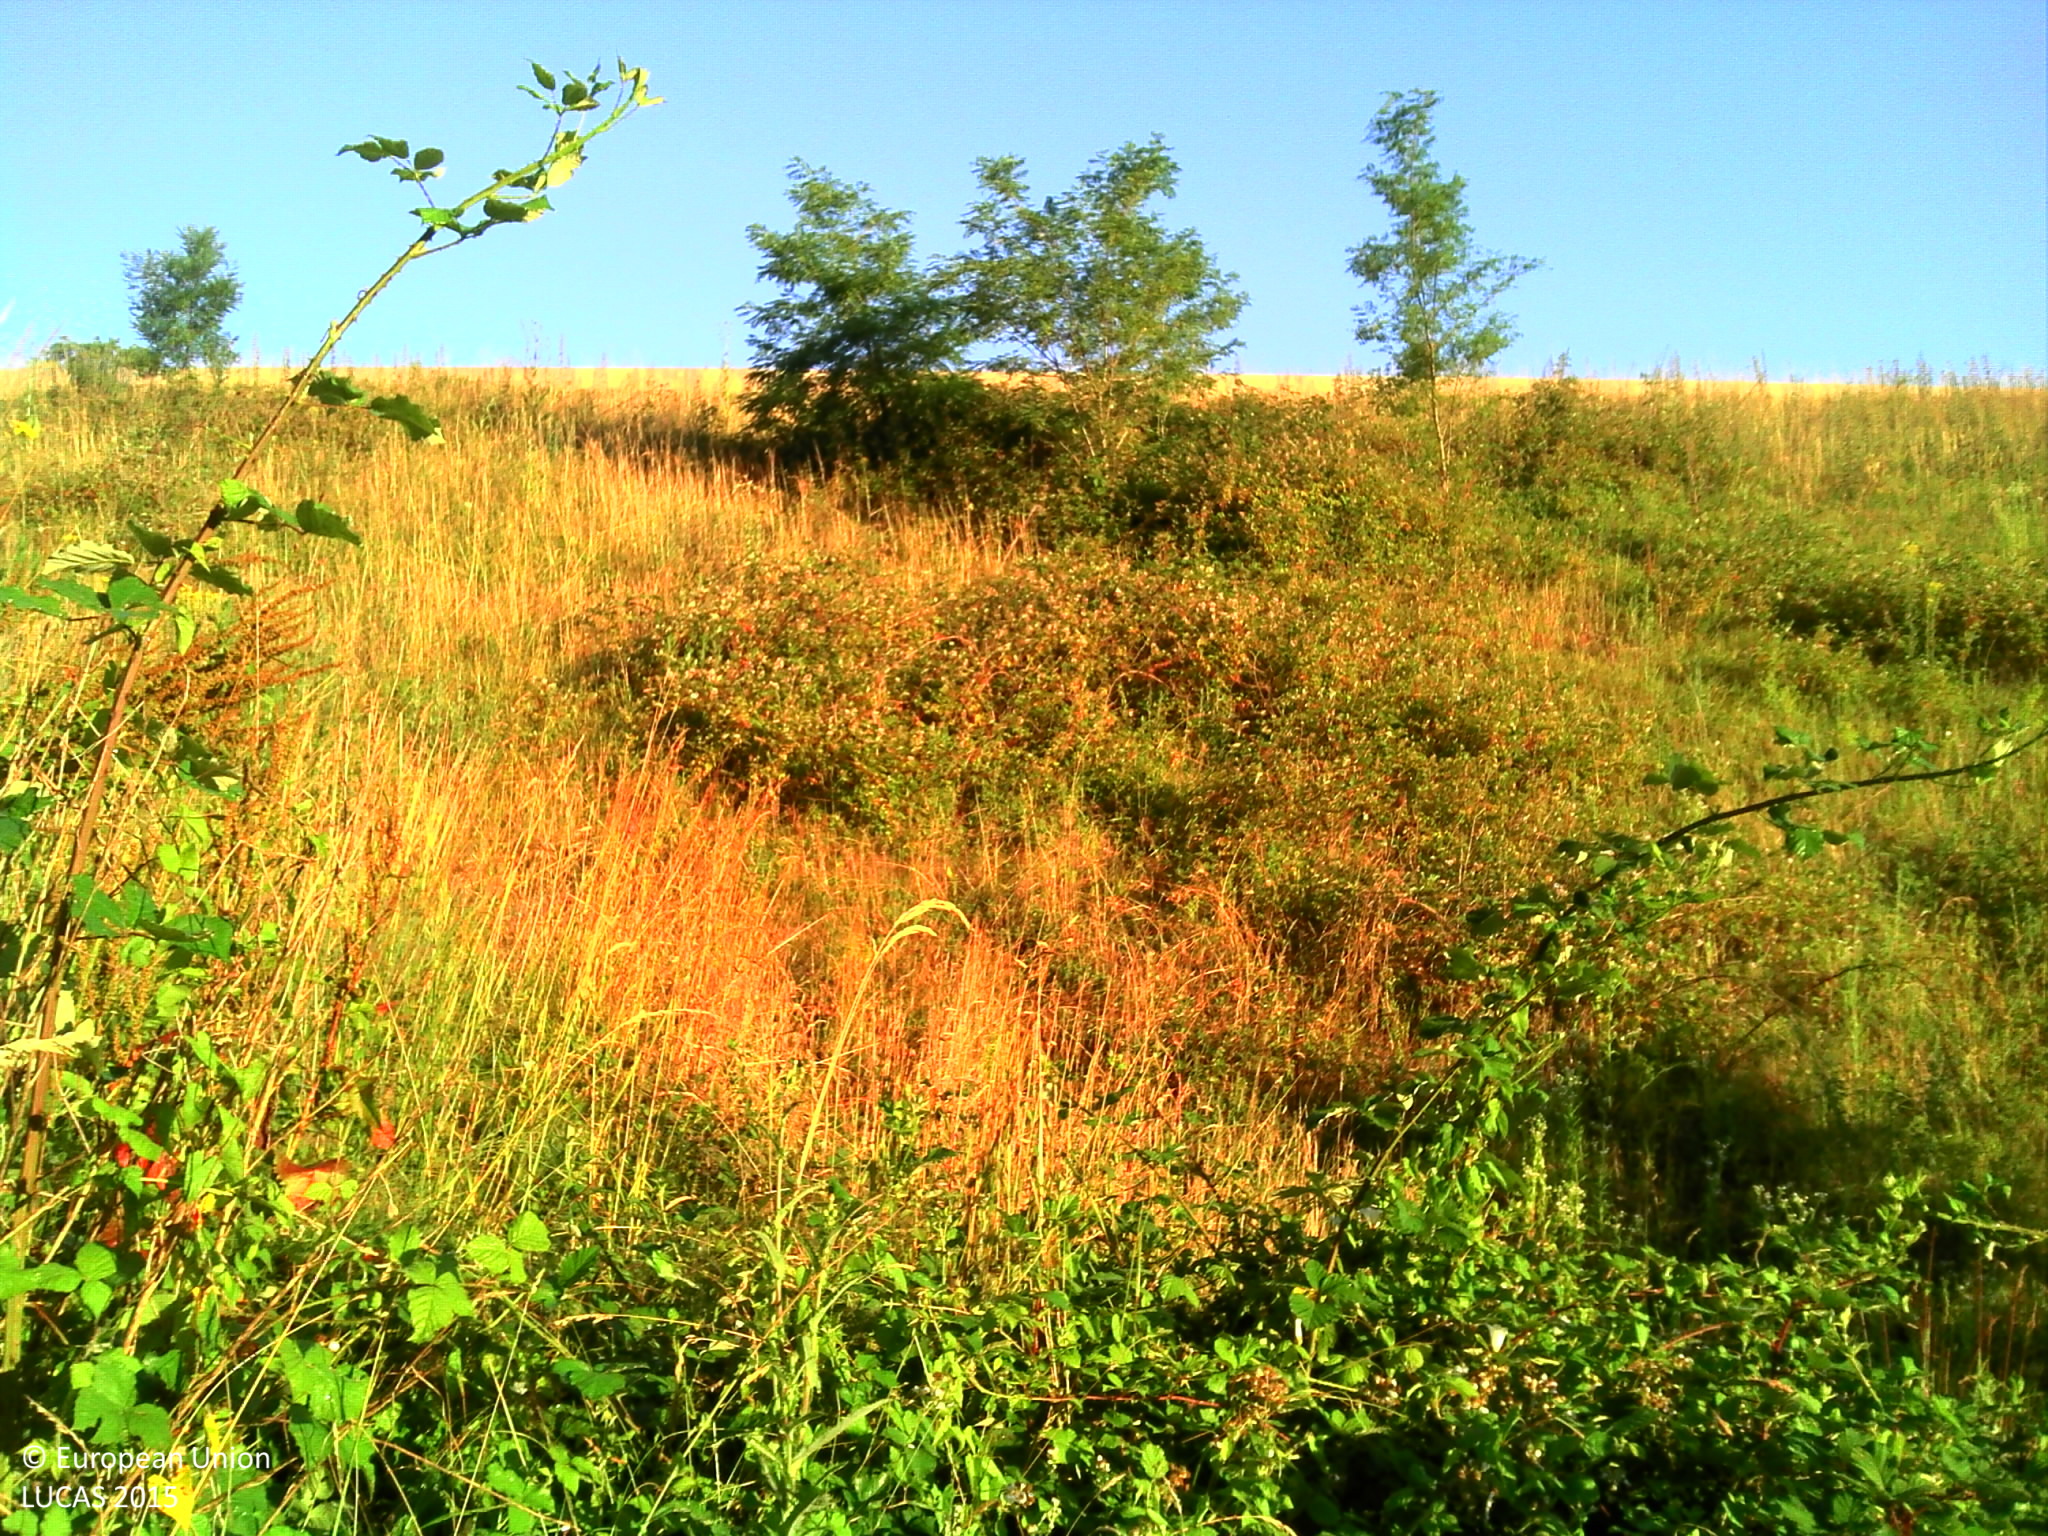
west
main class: Grassland
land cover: Spontaneously vegetated surfaces
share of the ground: > 75 %
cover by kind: herbaceous plants 95 %, shrubs 5 %
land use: Semi-natural and natural areas not in use
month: June
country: FR
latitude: 47.3966
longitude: 6.0665
